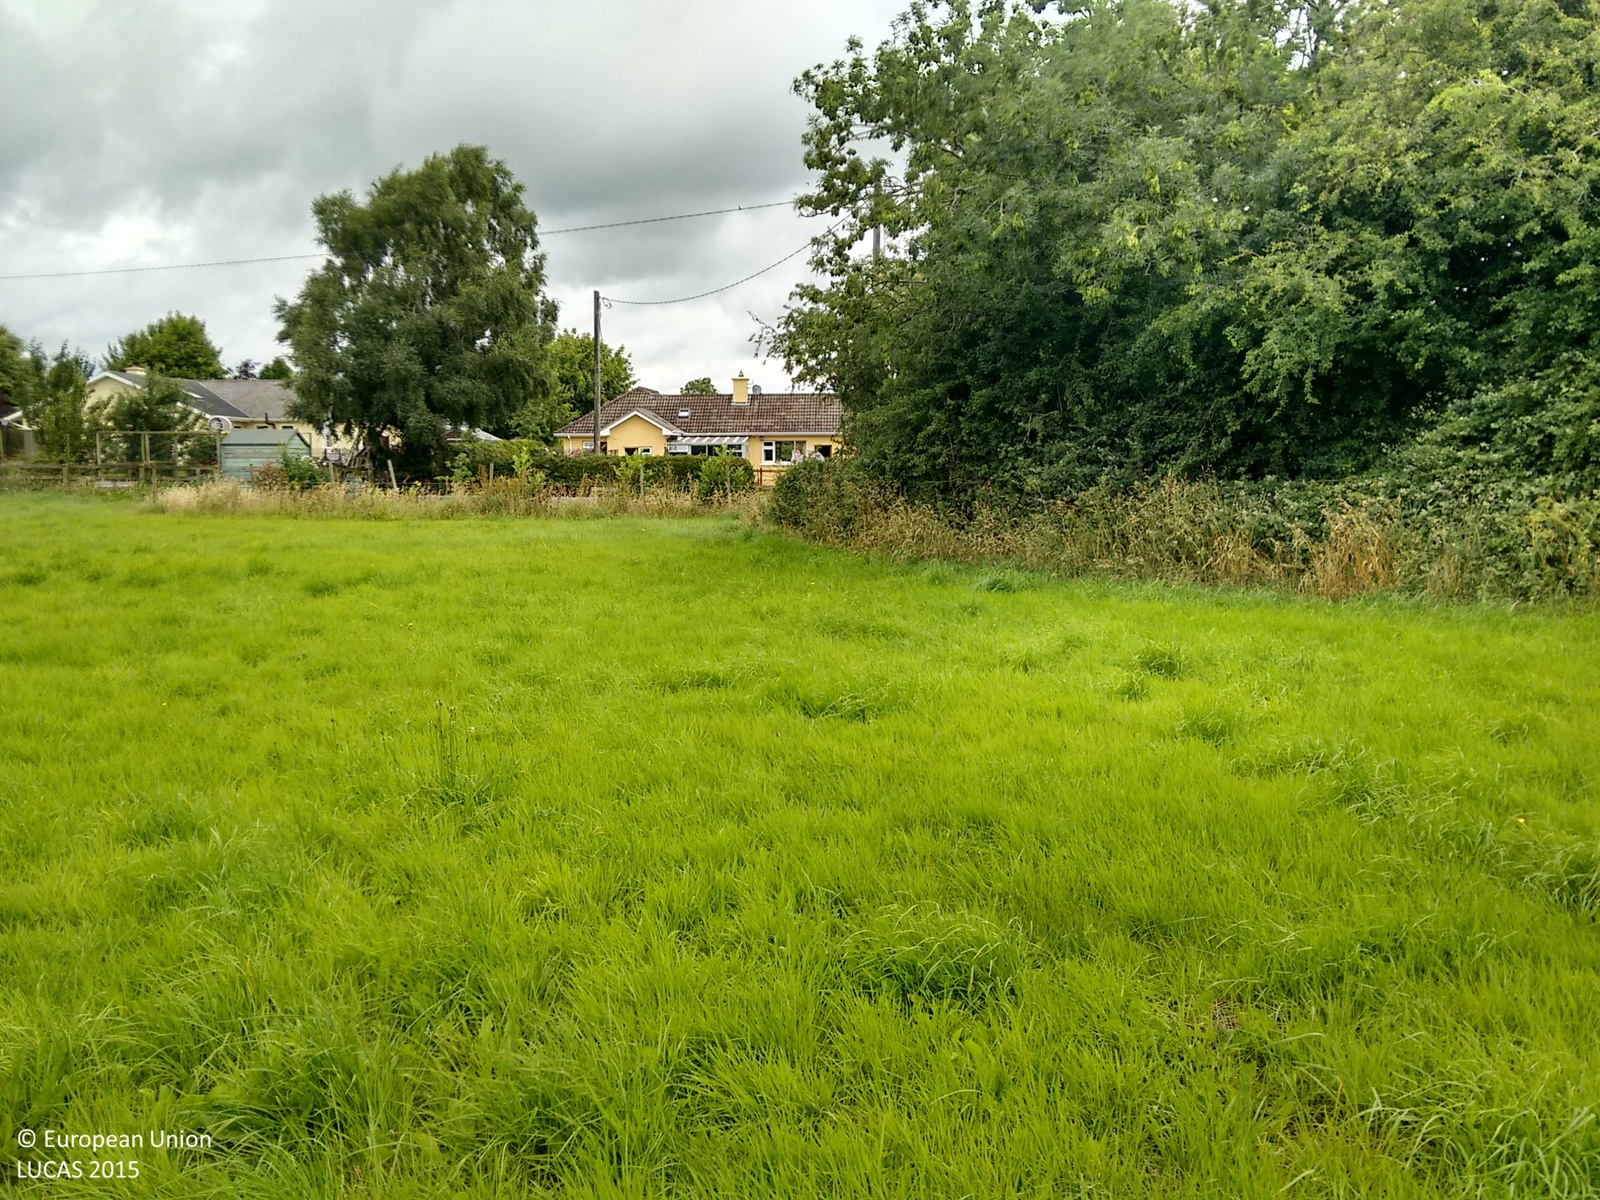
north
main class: Grassland
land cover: Grassland without tree/shrub cover
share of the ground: > 75 %
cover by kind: herbaceous plants 100 %
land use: Agriculture (excluding fallow land and kitchen gardens)
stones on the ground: < 10 %
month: July
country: IE
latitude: 52.5994
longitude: -7.3239
